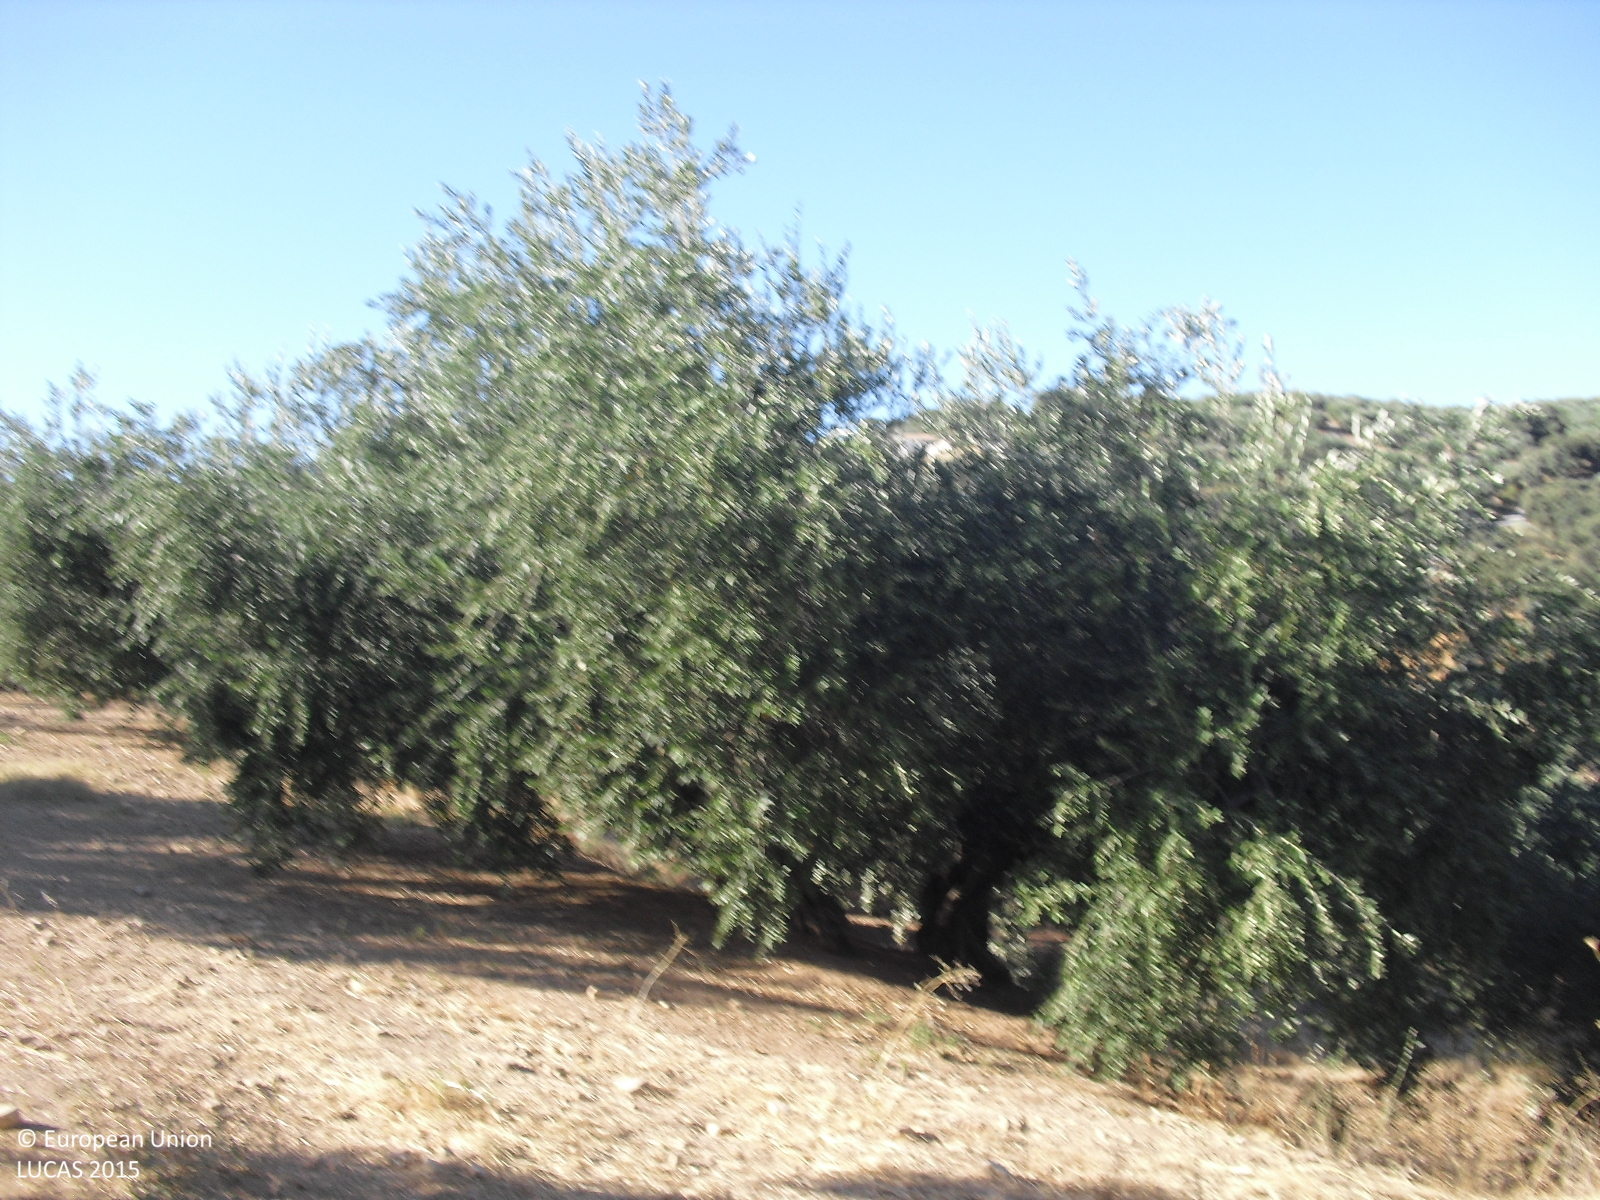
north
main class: Cropland
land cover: Olive groves
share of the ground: 25 - 50 %
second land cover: Other bare soil
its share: > 75 %
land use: Agriculture (excluding fallow land and kitchen gardens)
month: August
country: ES
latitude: 37.2897
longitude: -4.1531
